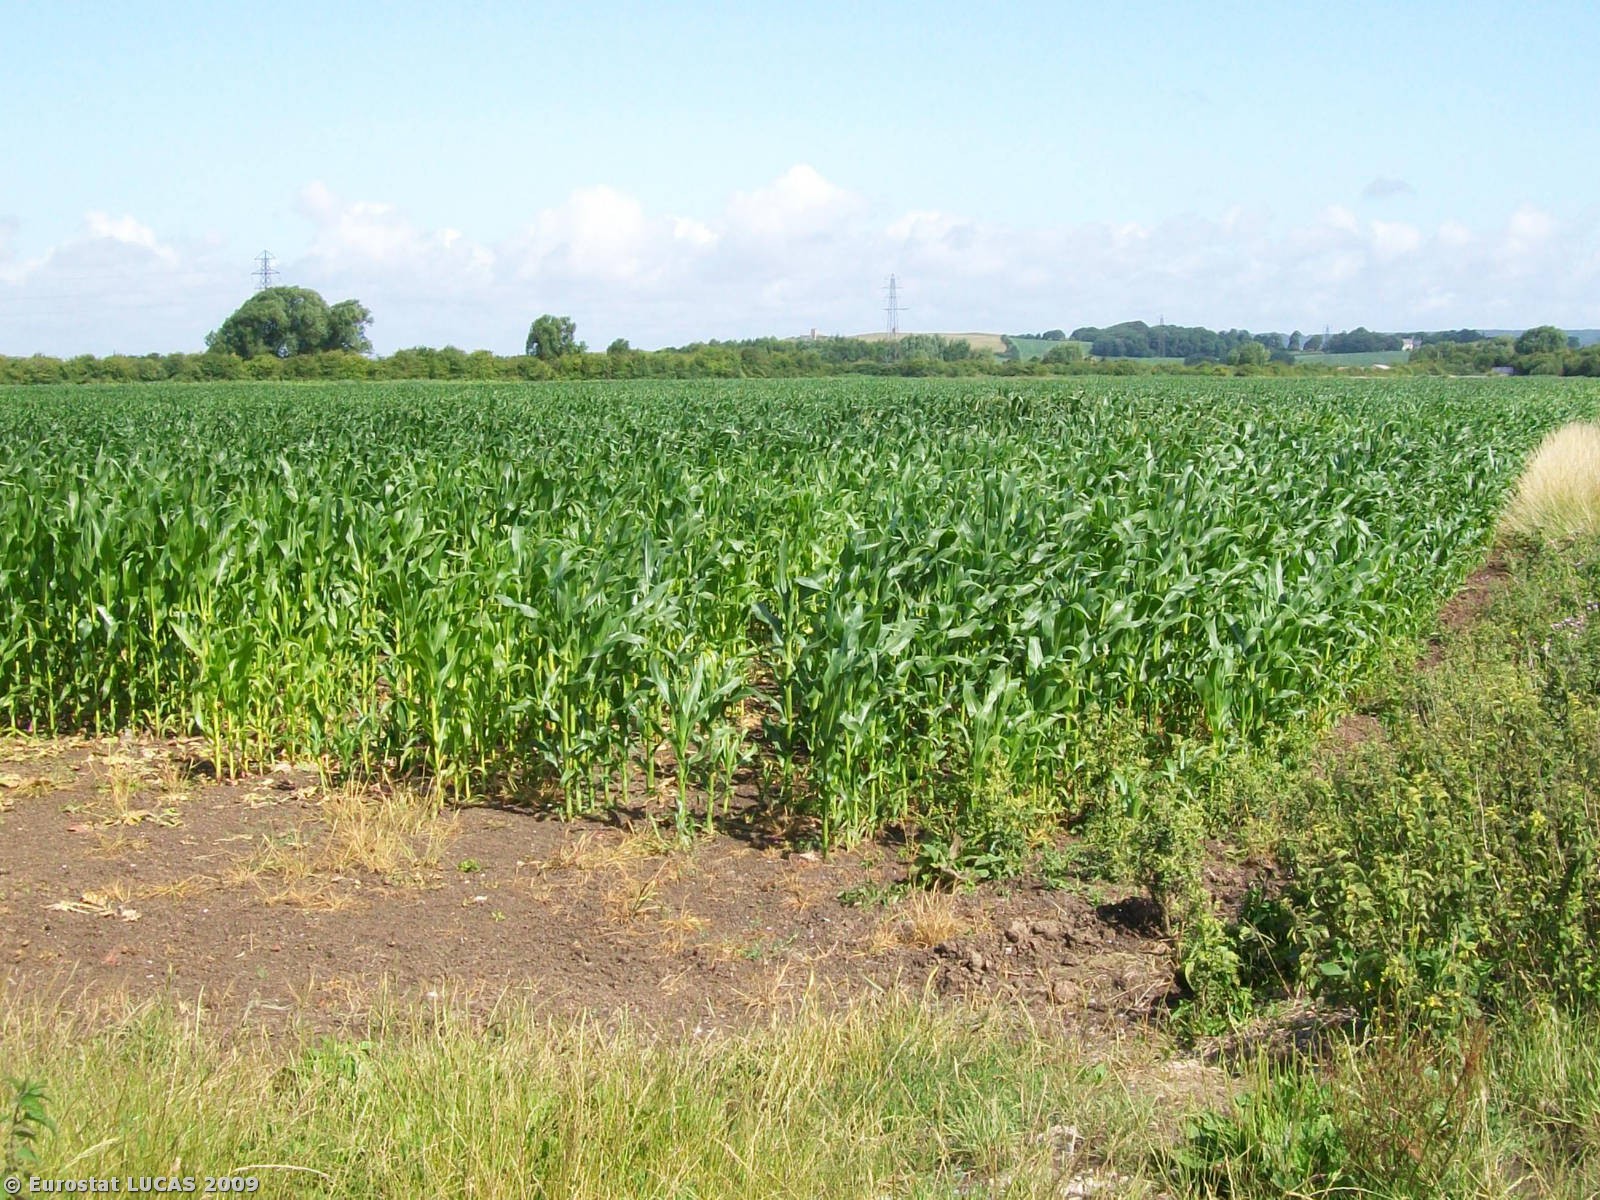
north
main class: Cropland
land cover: Maize
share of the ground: > 75 %
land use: Agriculture (excluding fallow land and kitchen gardens)
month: July
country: GB
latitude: 51.2979
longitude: -2.9679
